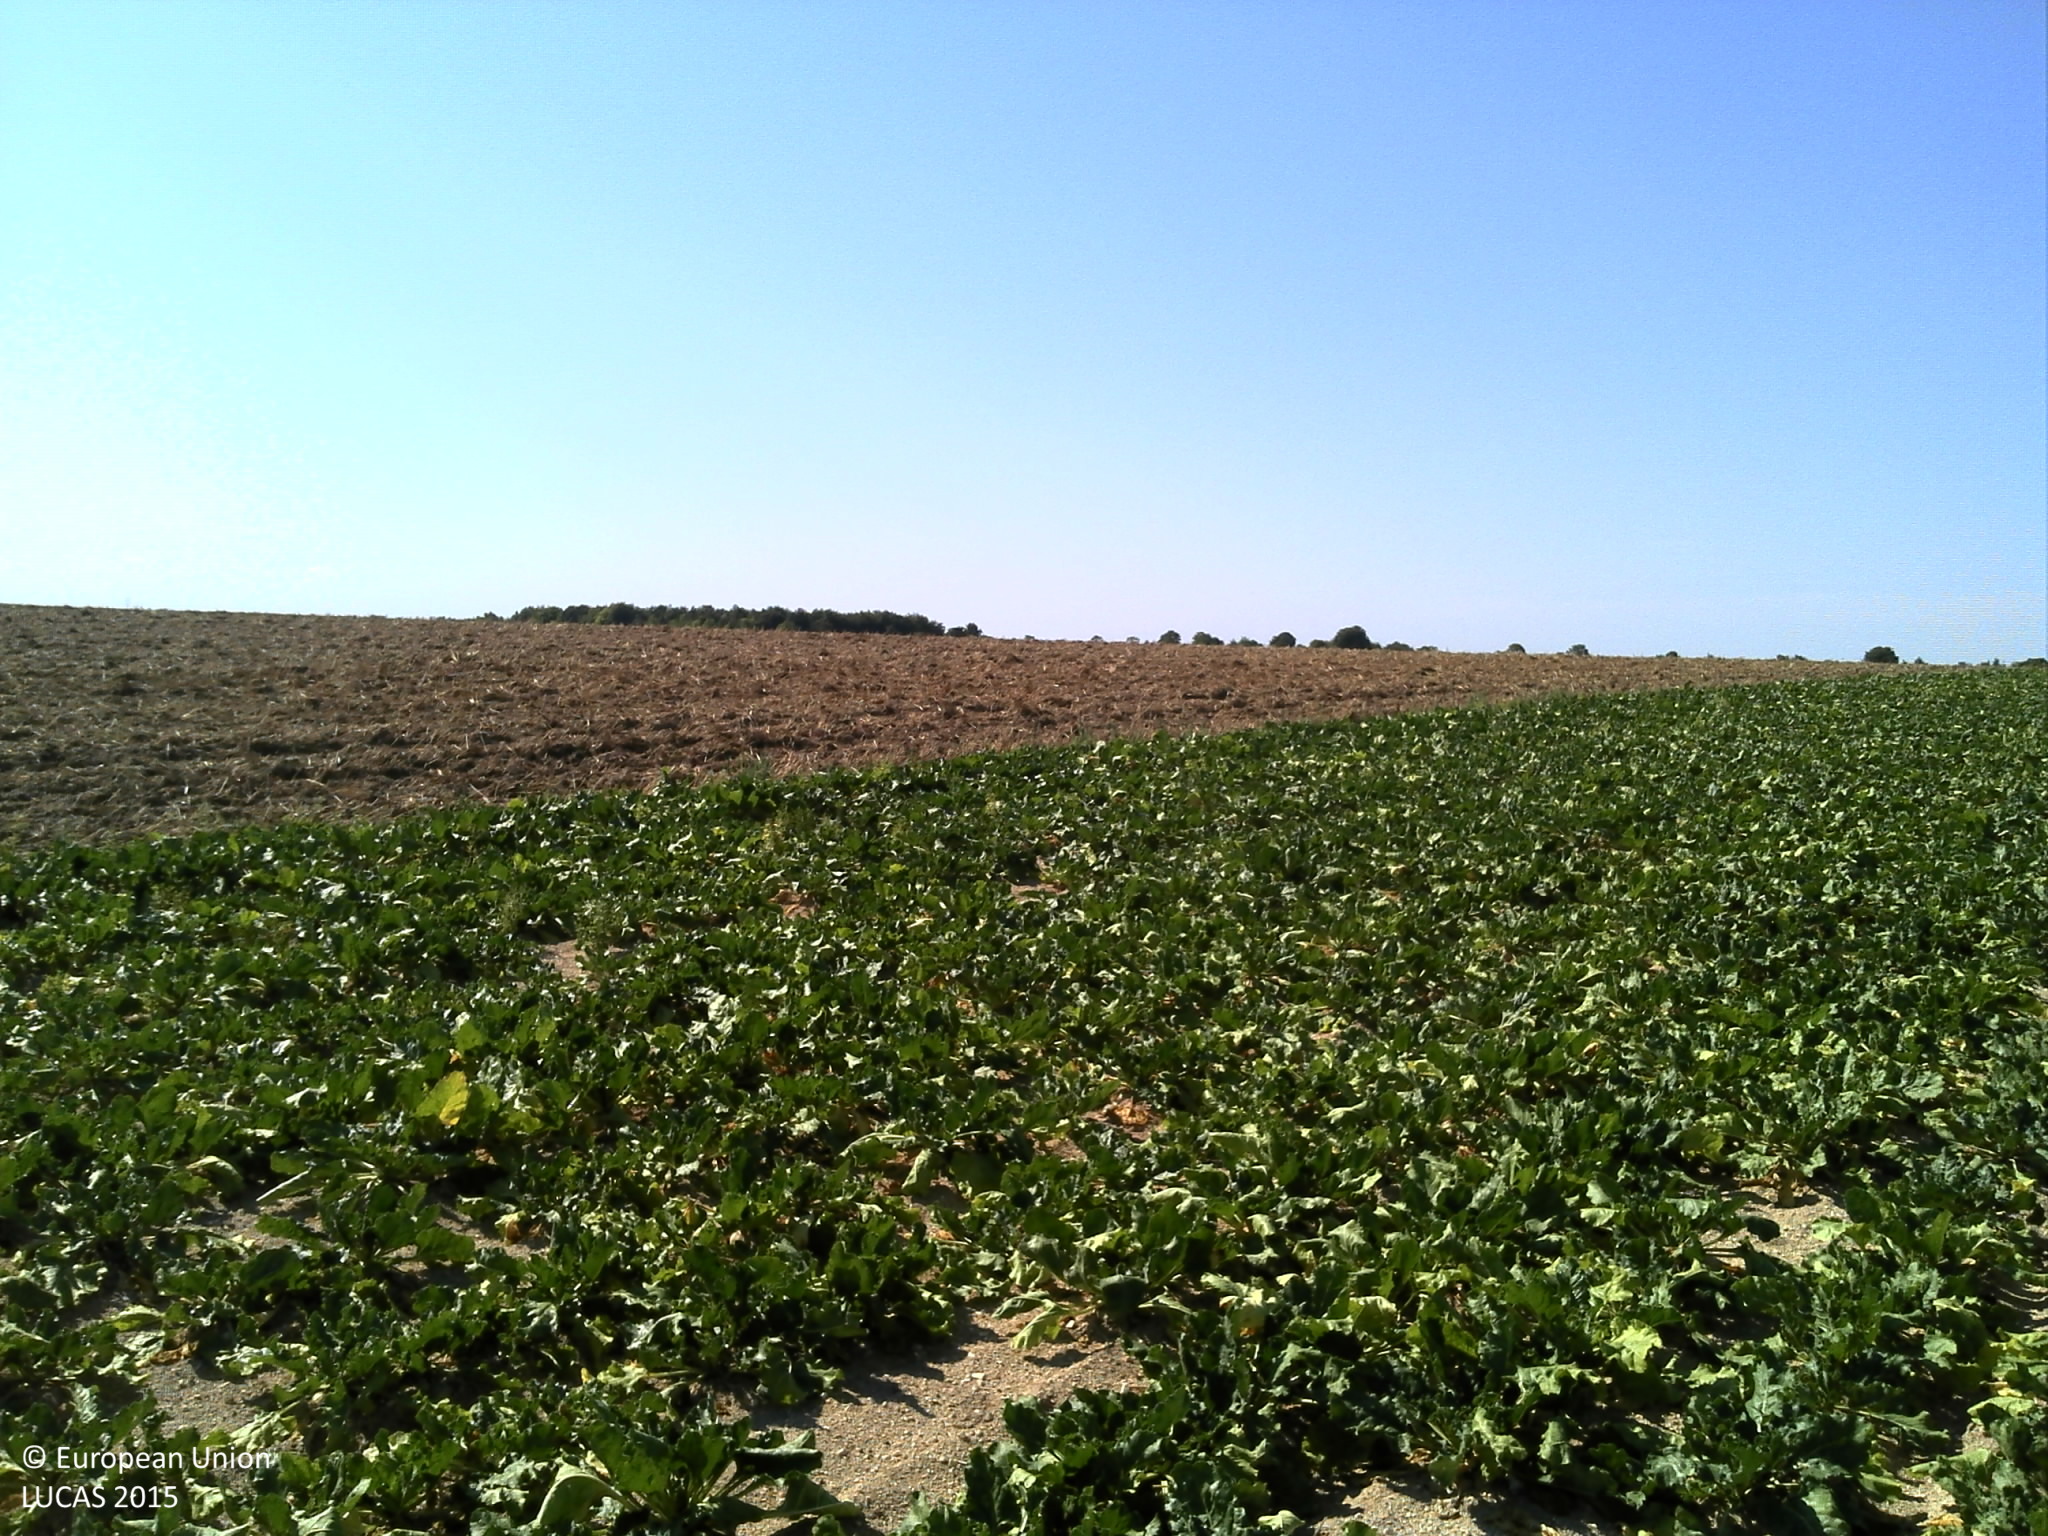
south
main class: Cropland
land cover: Sugar beet
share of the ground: > 75 %
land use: Agriculture (excluding fallow land and kitchen gardens)
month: August
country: FR
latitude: 48.5655
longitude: 4.3459
